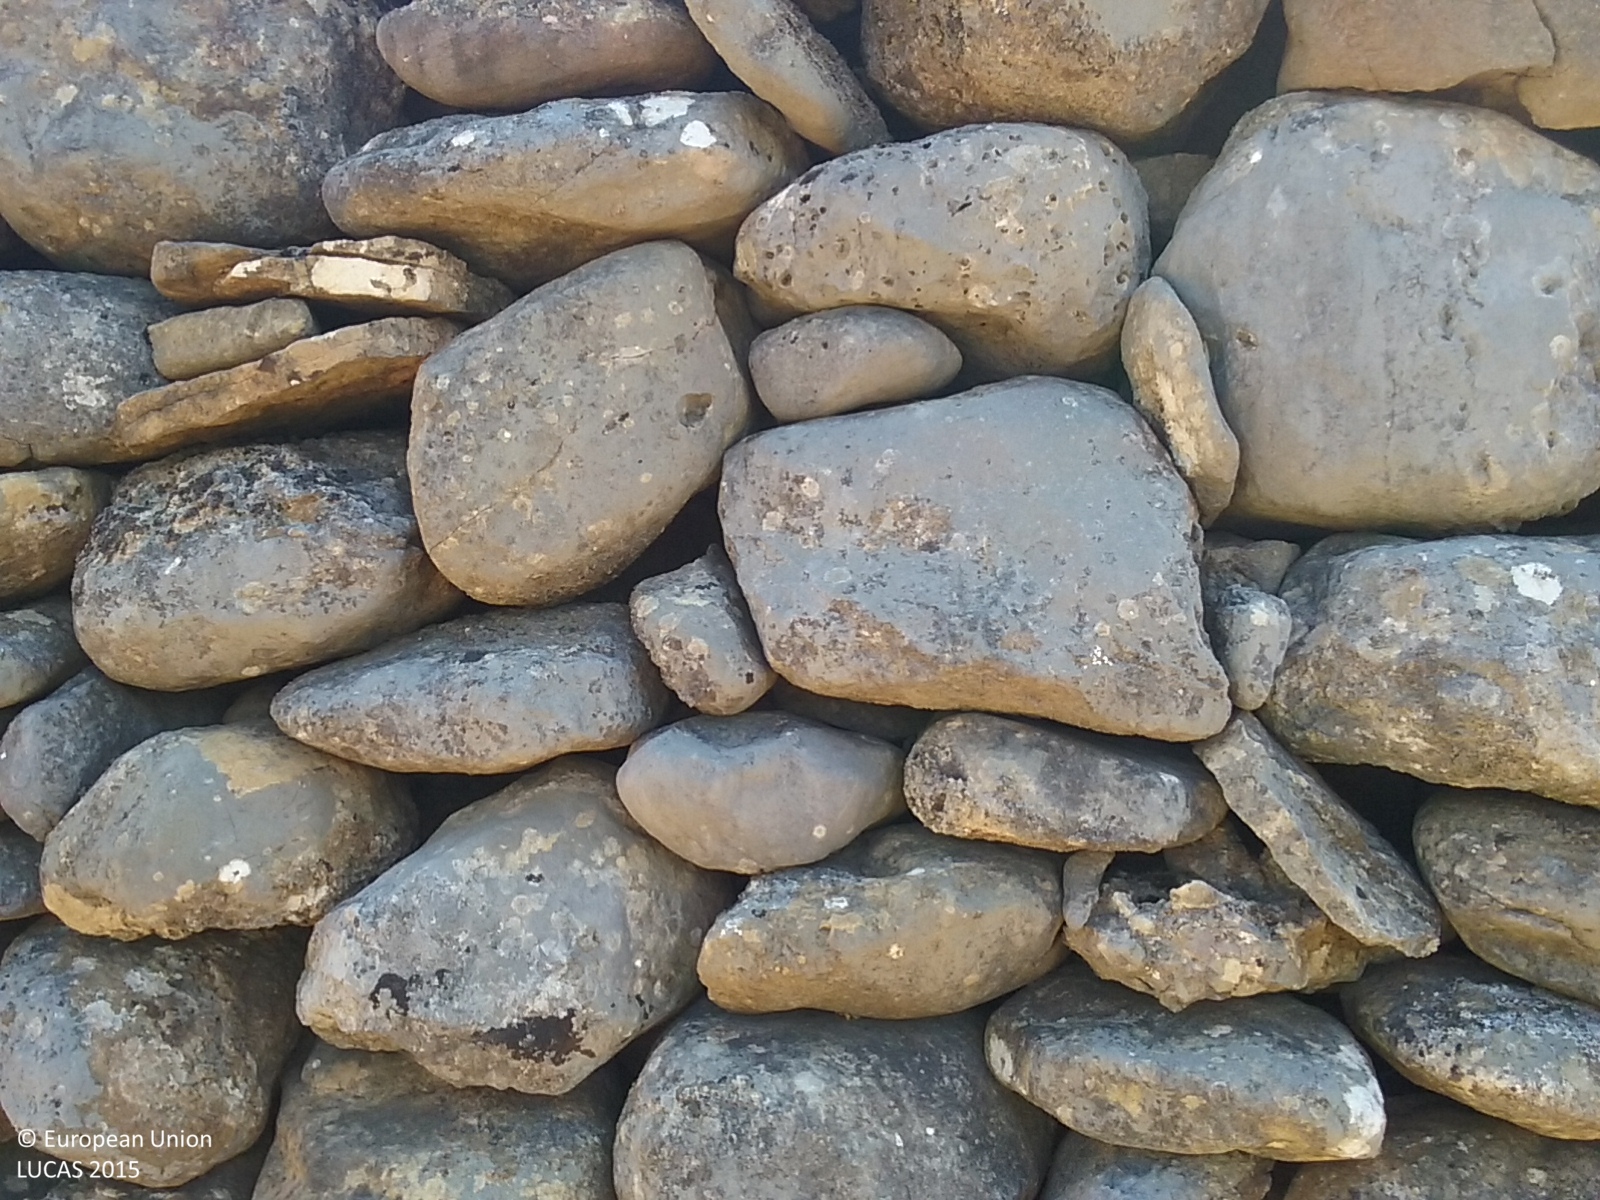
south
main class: Cropland
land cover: Nuts trees
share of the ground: 25 - 50 %
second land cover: Other bare soil
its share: > 75 %
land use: Agriculture (excluding fallow land and kitchen gardens)
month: May
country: ES
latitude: 40.3693
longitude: -0.0505
